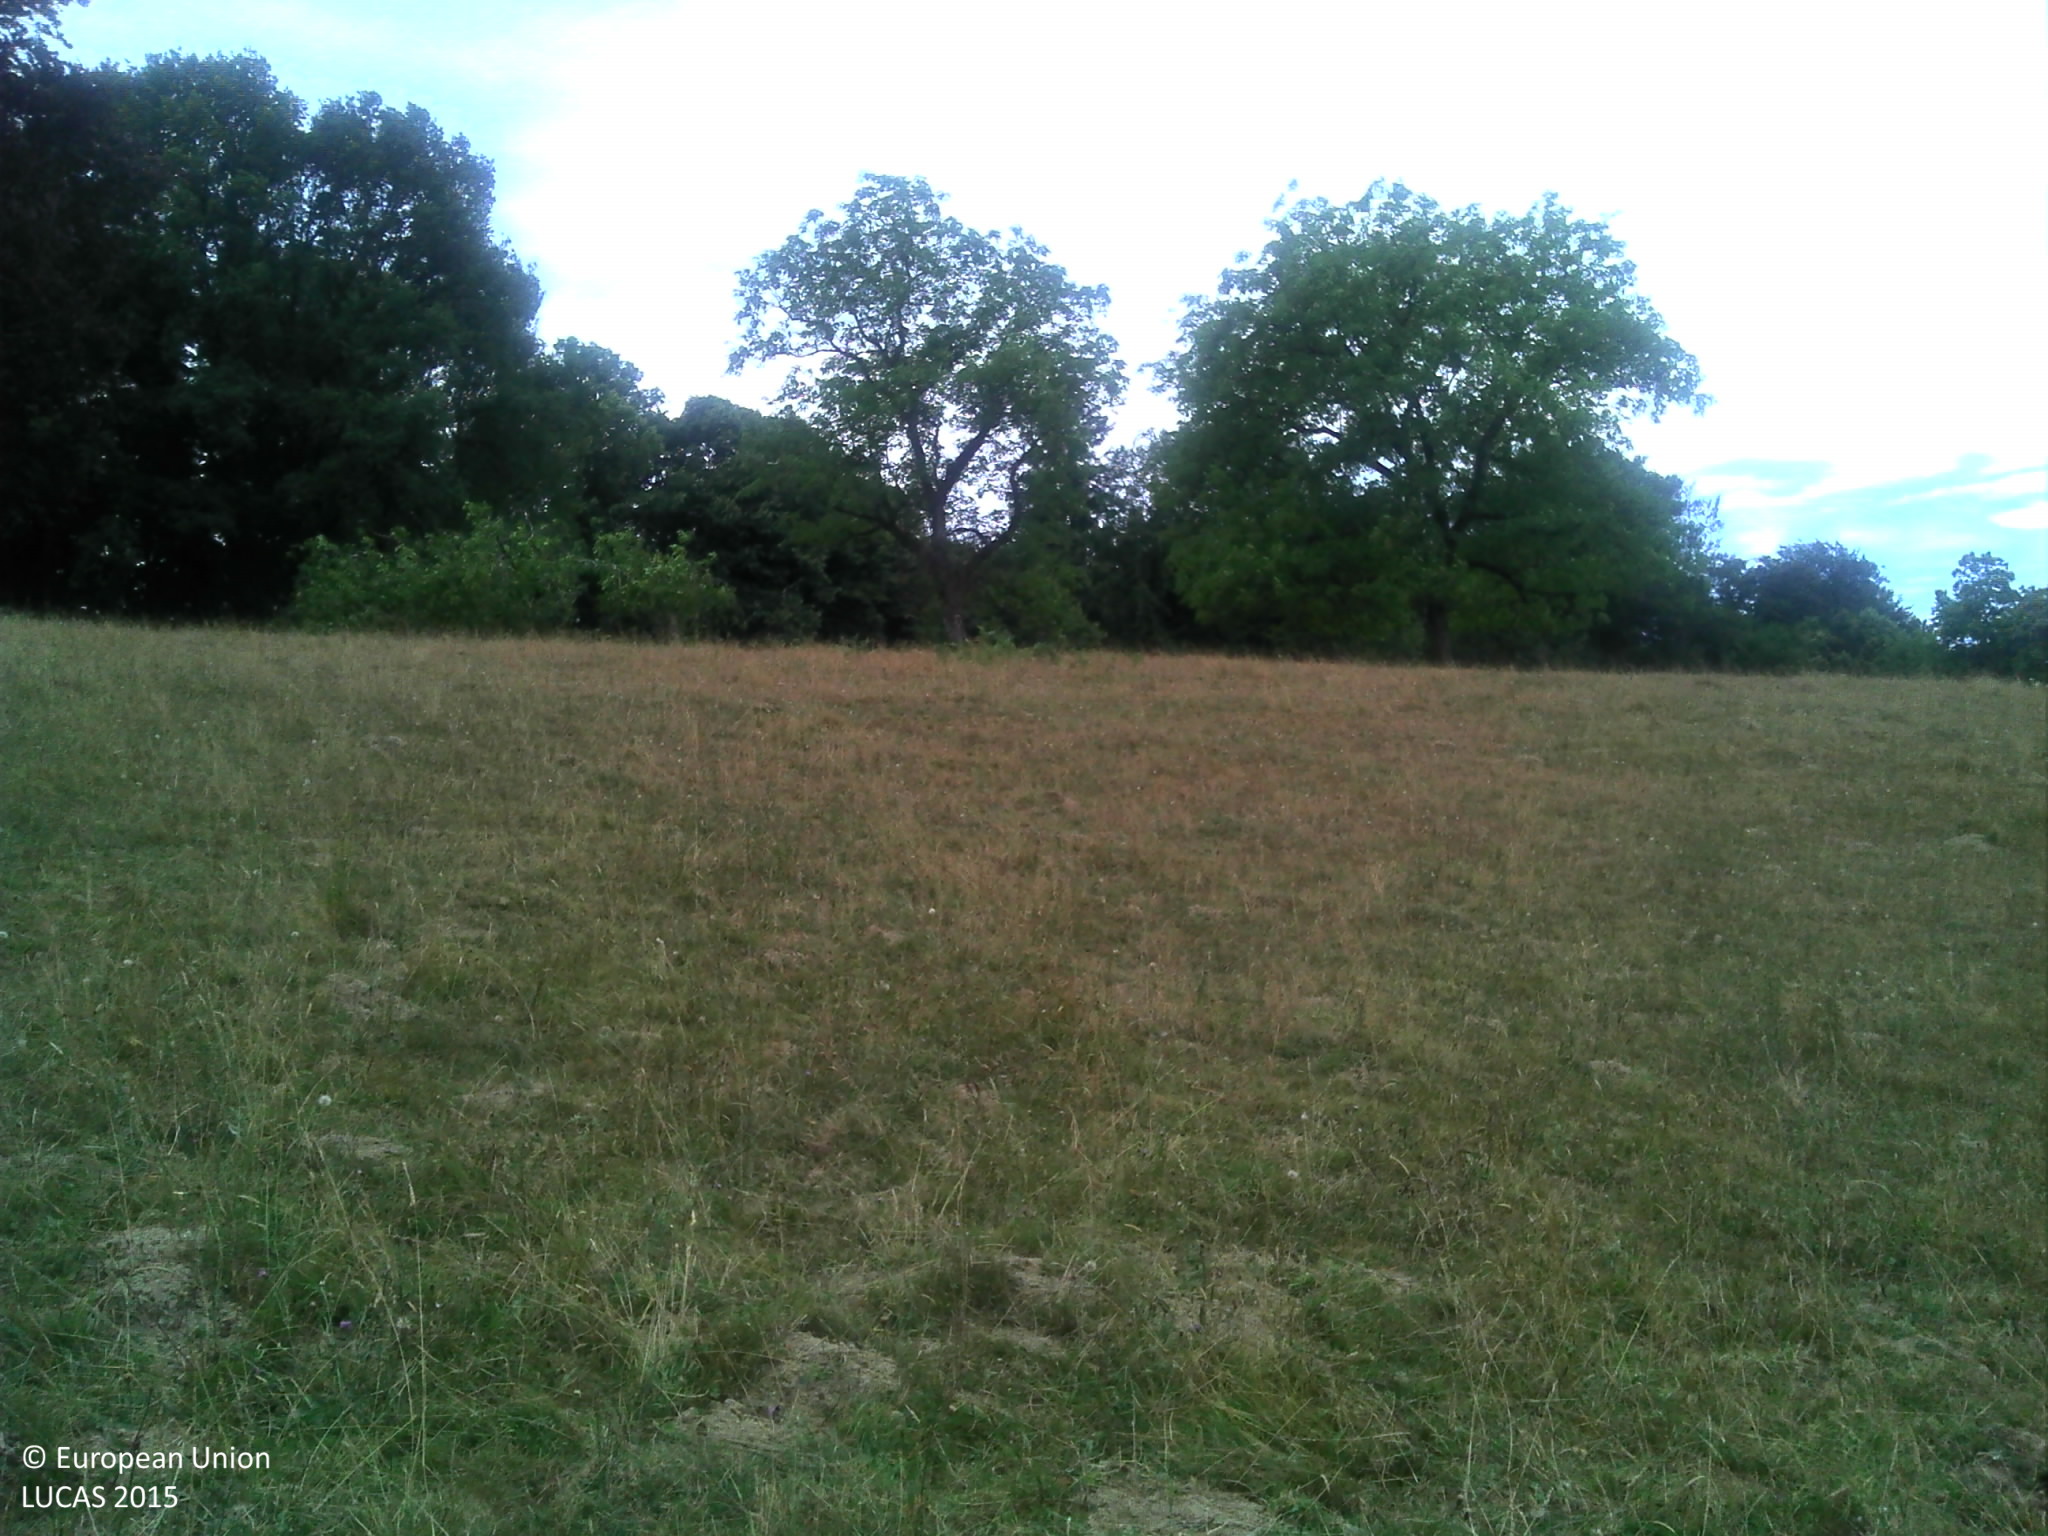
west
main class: Grassland
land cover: Grassland without tree/shrub cover
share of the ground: > 75 %
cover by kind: herbaceous plants 100 %
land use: Agriculture (excluding fallow land and kitchen gardens)
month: July
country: FR
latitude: 45.5218
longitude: 1.4797
